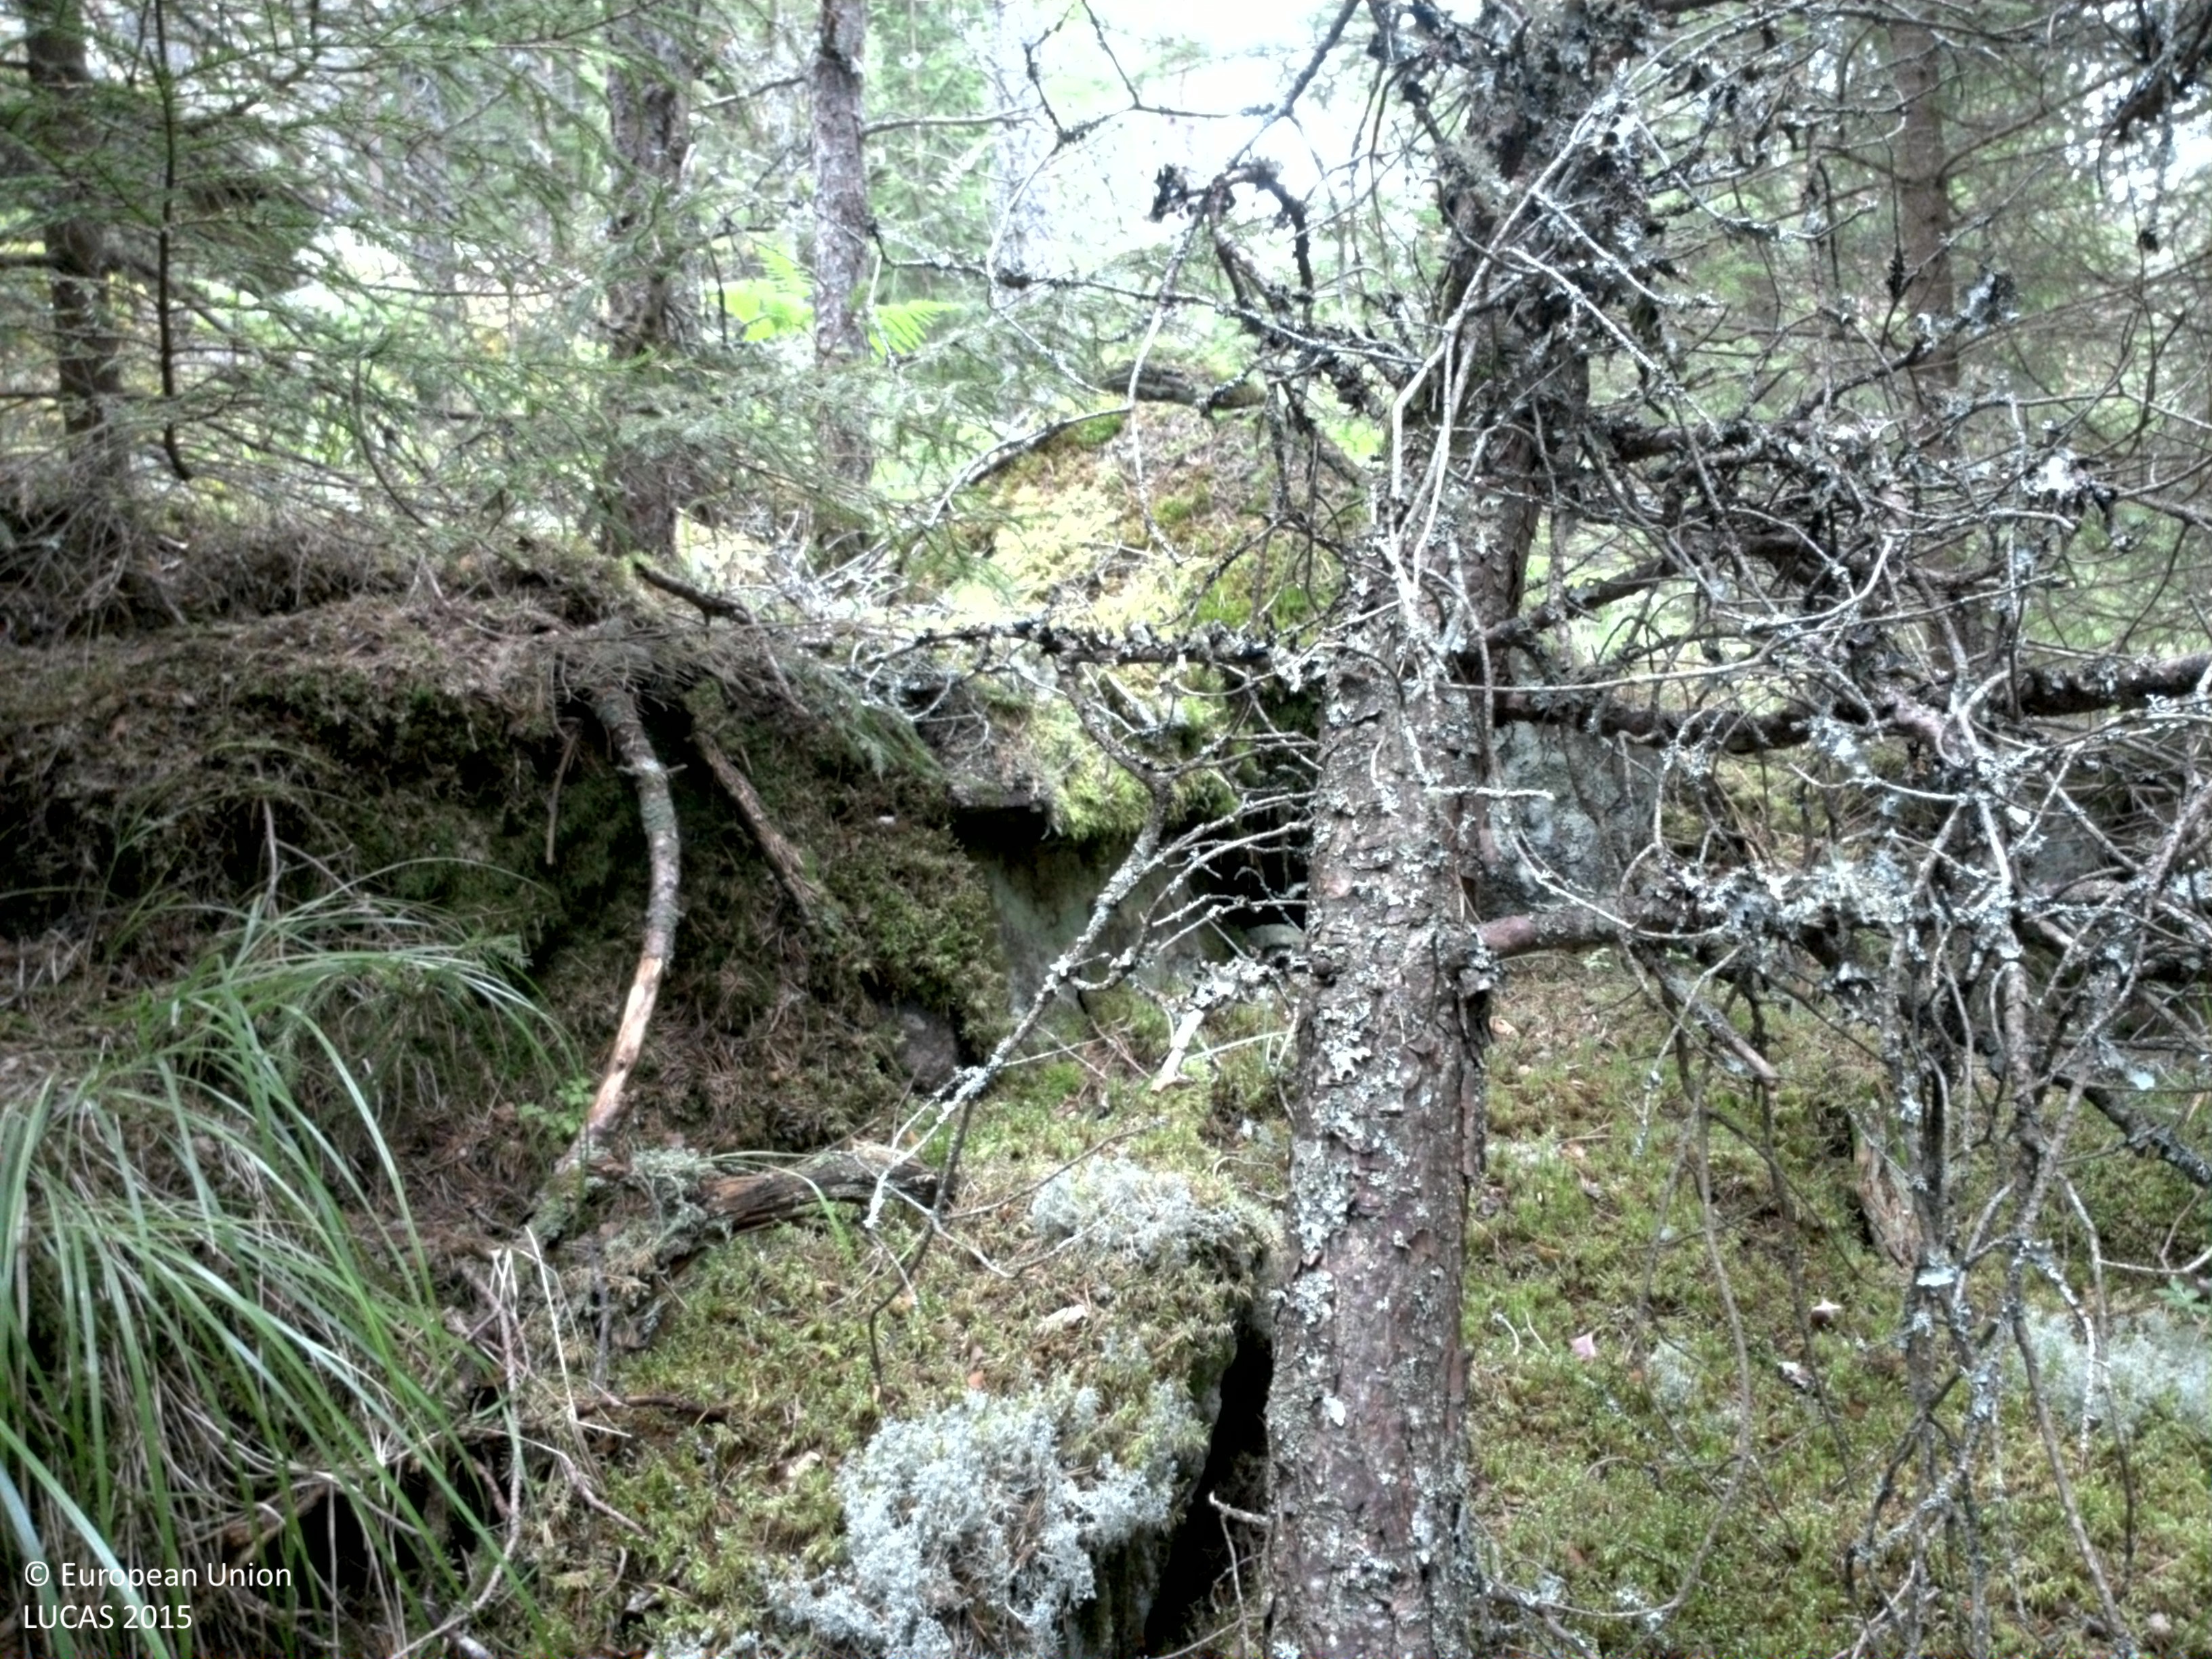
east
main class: Woodland
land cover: Spruce dominated coniferous woodland
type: boreal forest
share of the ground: 50 - 75 %
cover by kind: coniferous forest trees 70 %, lichens and mosses 25 %, shrubs 5 %
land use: Forestry
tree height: > 5 m
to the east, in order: Spruce dominated coniferous woodland; Pine dominated coniferous woodland; Spruce dominated coniferous woodland; Rivers and streams; Spruce dominated coniferous woodland; Tracks; Spruce dominated coniferous woodland; Pine dominated coniferous woodland; Shrubland with sparse tree cover; Pine dominated coniferous woodland
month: August
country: SE
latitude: 59.3565
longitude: 11.9826
